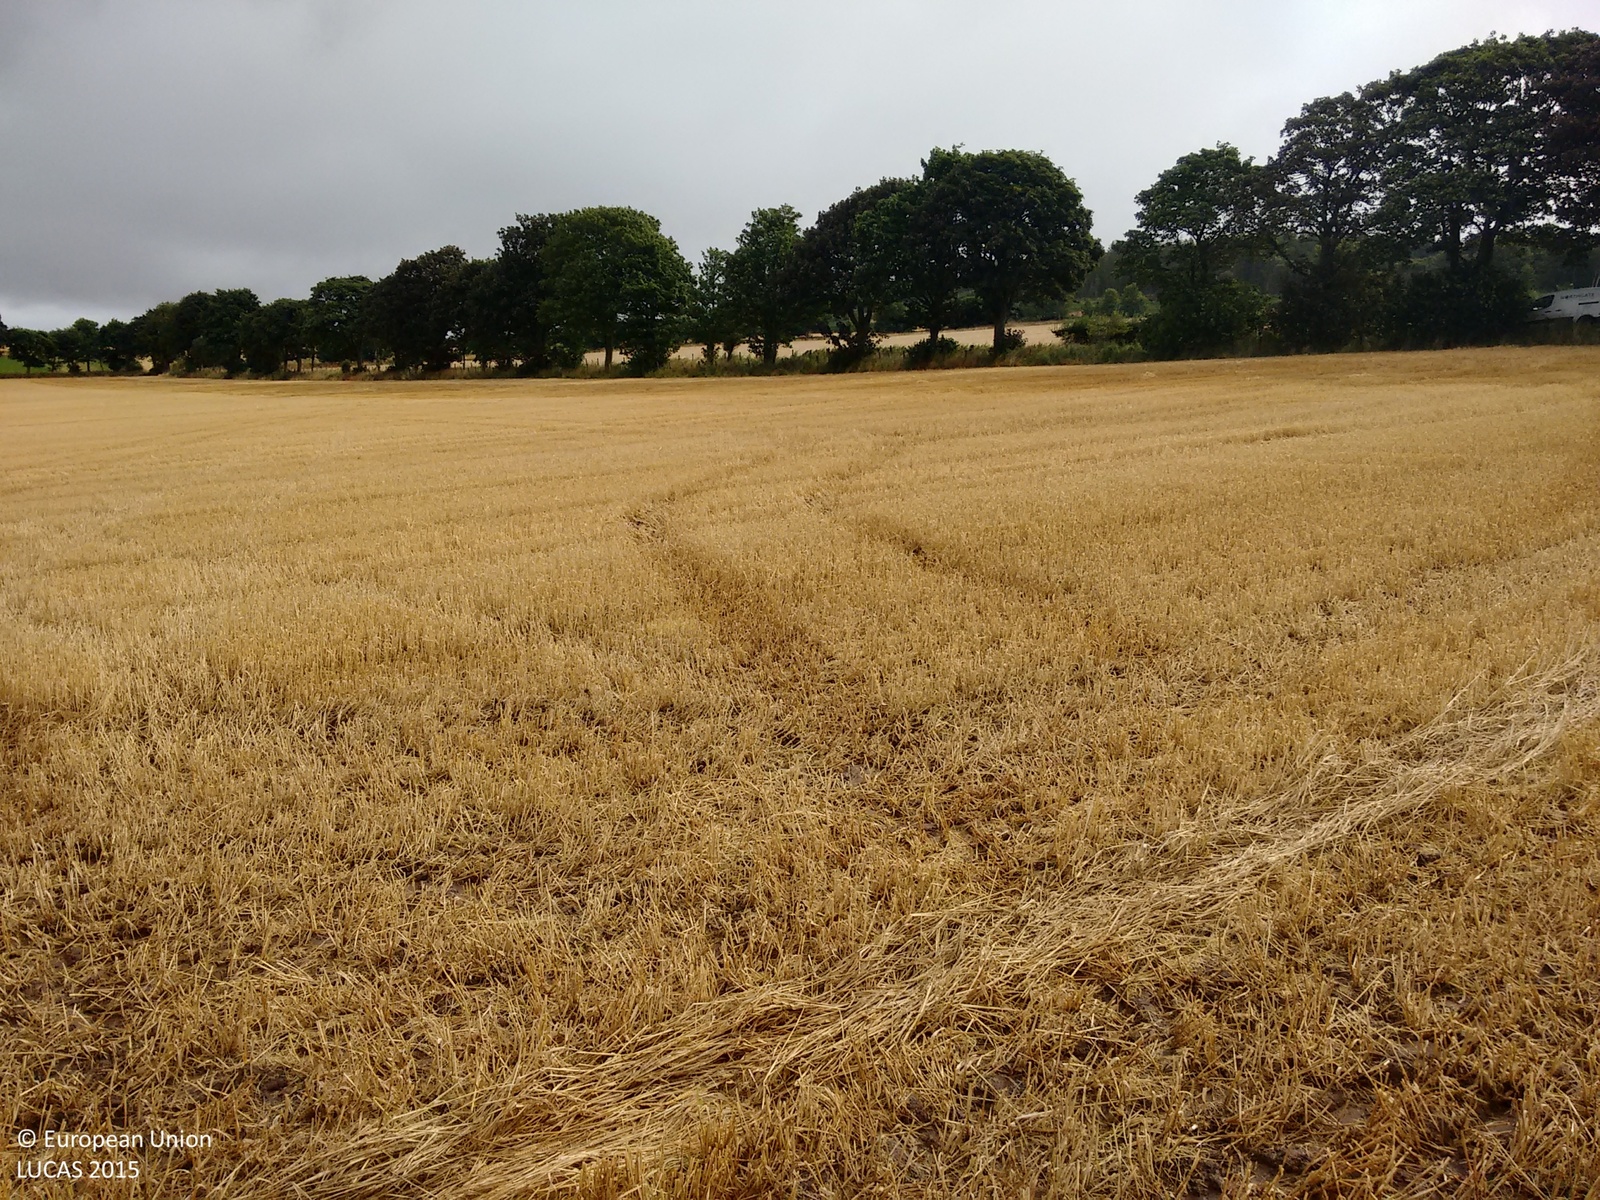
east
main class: Cropland
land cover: Barley
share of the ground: 10 - 25 %
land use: Agriculture (excluding fallow land and kitchen gardens)
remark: Harvested field
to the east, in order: Barley; Grass margins; Fences; Lines of trees; Tracks; Grass margins; Fences; Grass margins; Rape and turnip rape
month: September
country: GB
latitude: 57.6550
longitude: -3.3903
